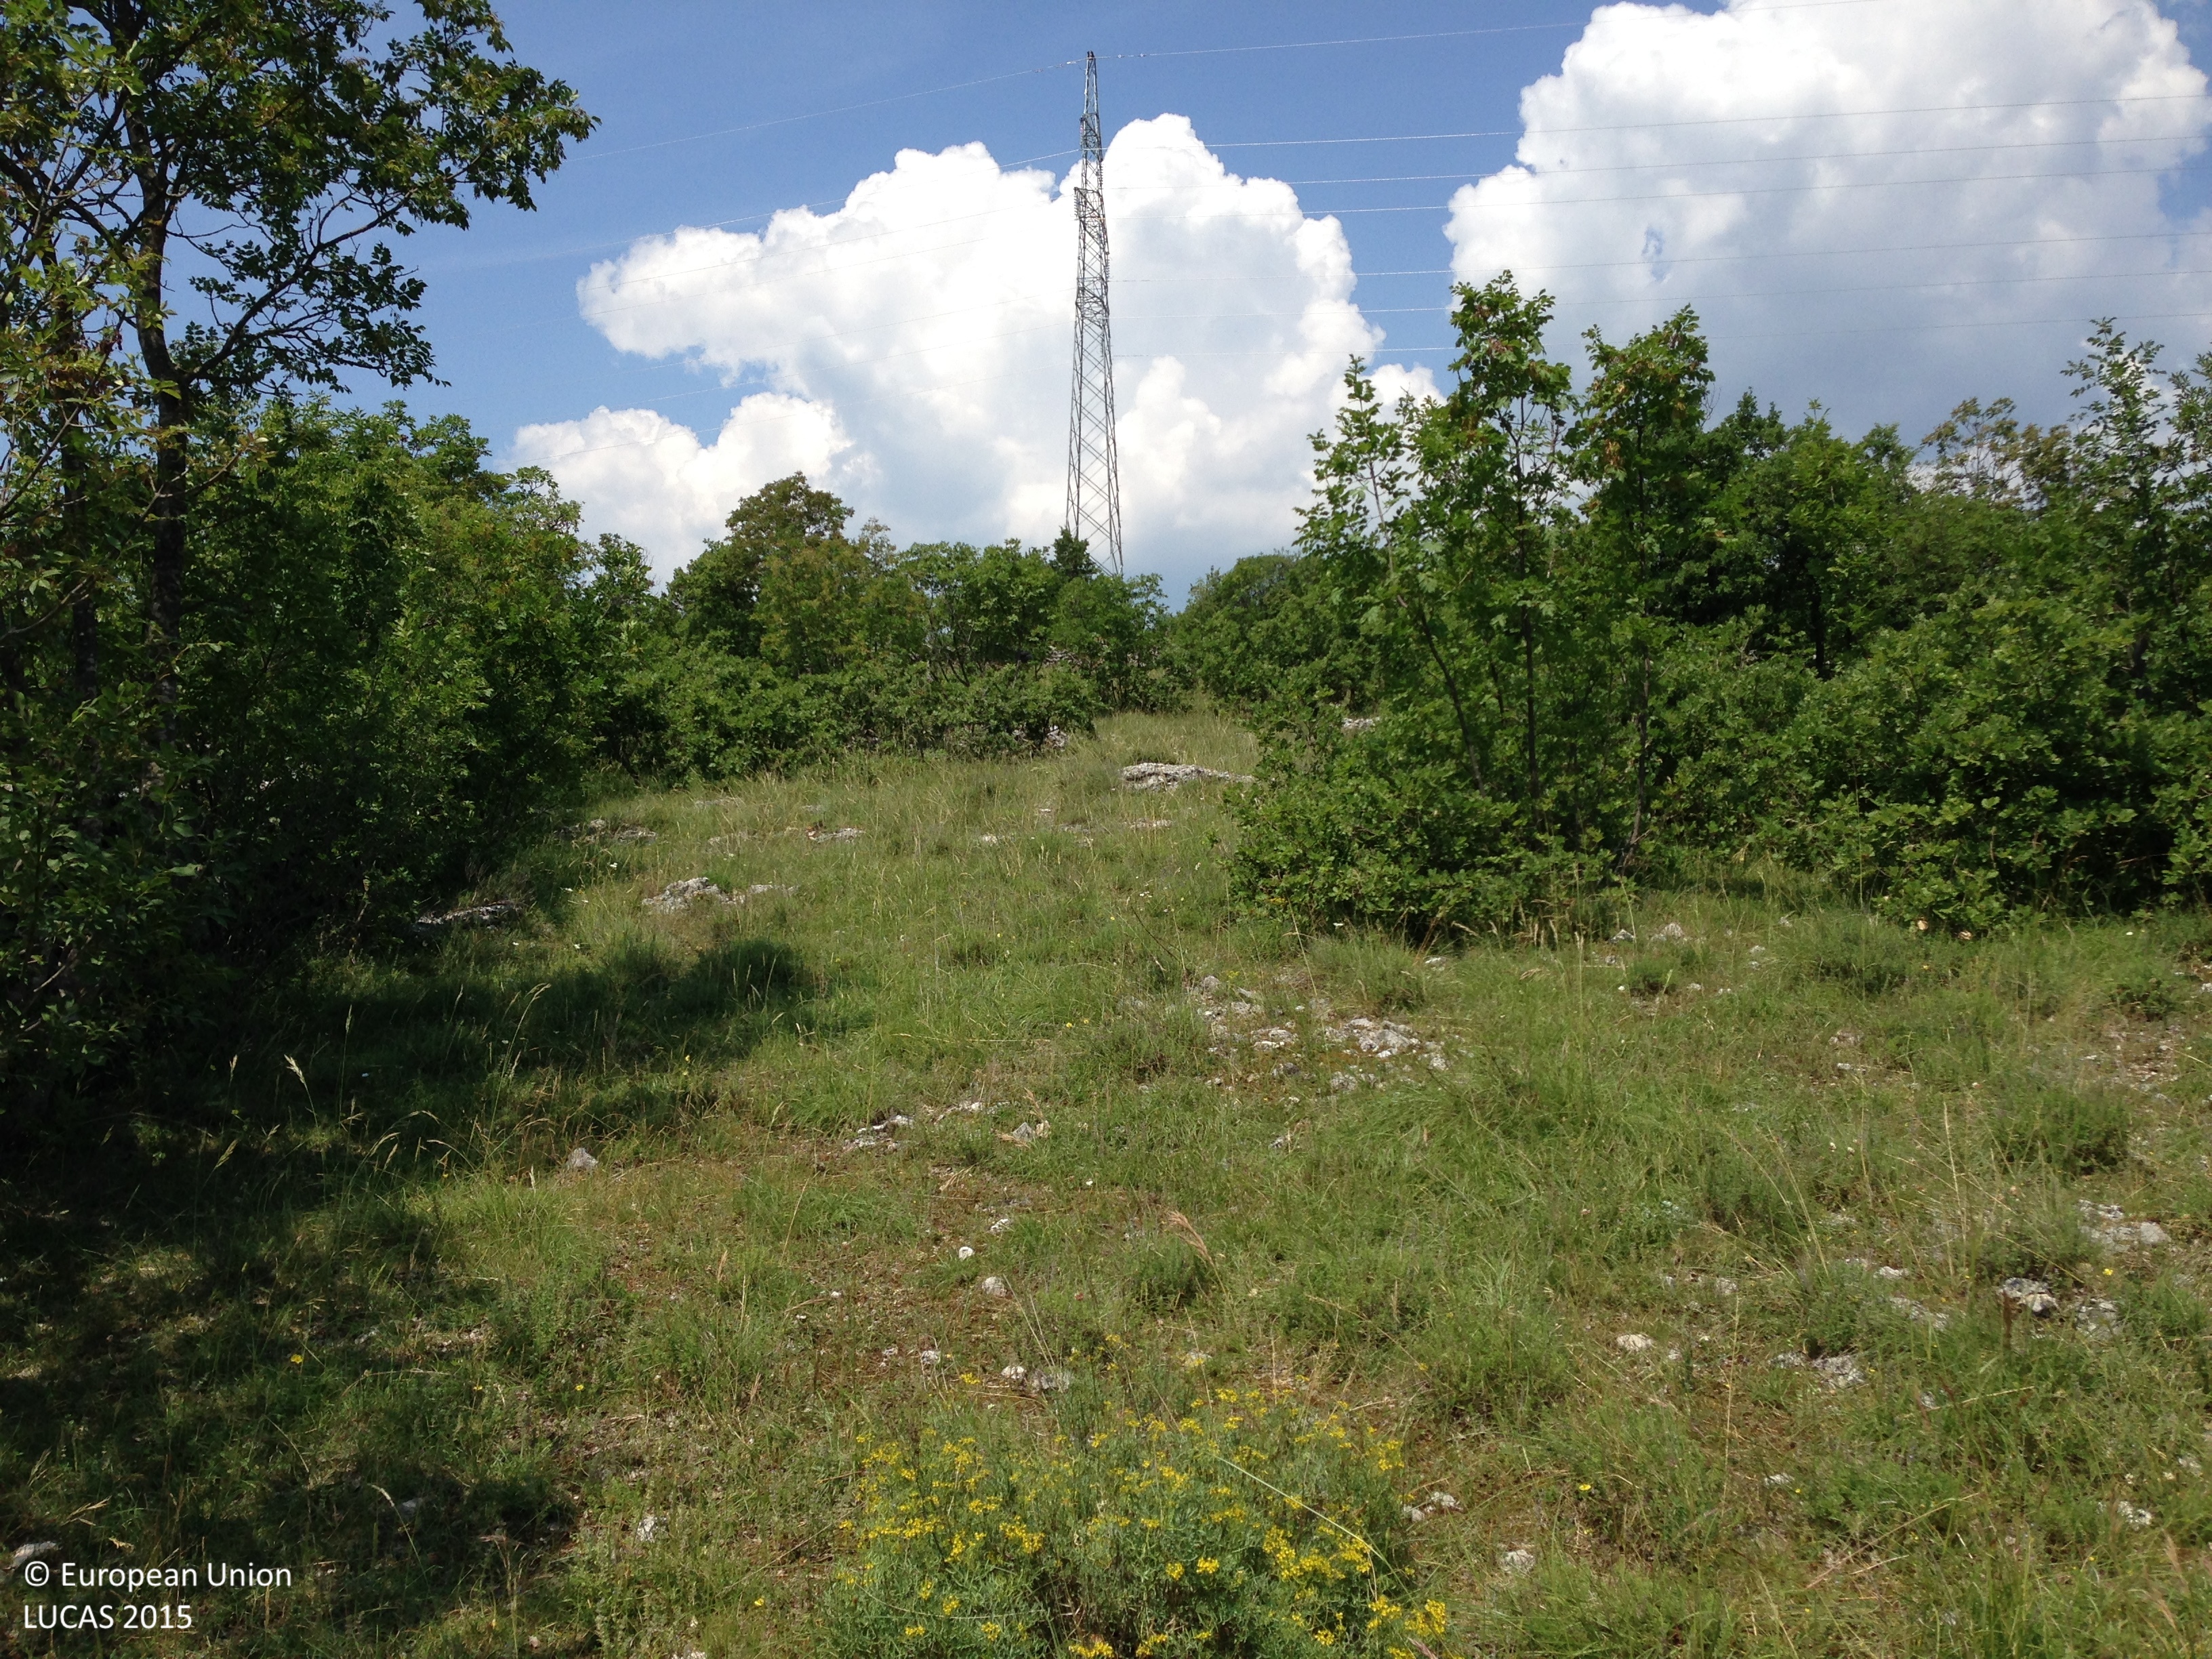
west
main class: Grassland
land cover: Grassland with sparse tree/shrub cover
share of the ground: > 75 %
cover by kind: herbaceous plants 70 %, shrubs 10 %, unconsolidated bare surface 10 %, broadleaved forest trees 5 %, consolidated bare surface 5 %
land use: Abandoned areas
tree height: < 5 m
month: June
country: HR
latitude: 43.6760
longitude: 16.5034
